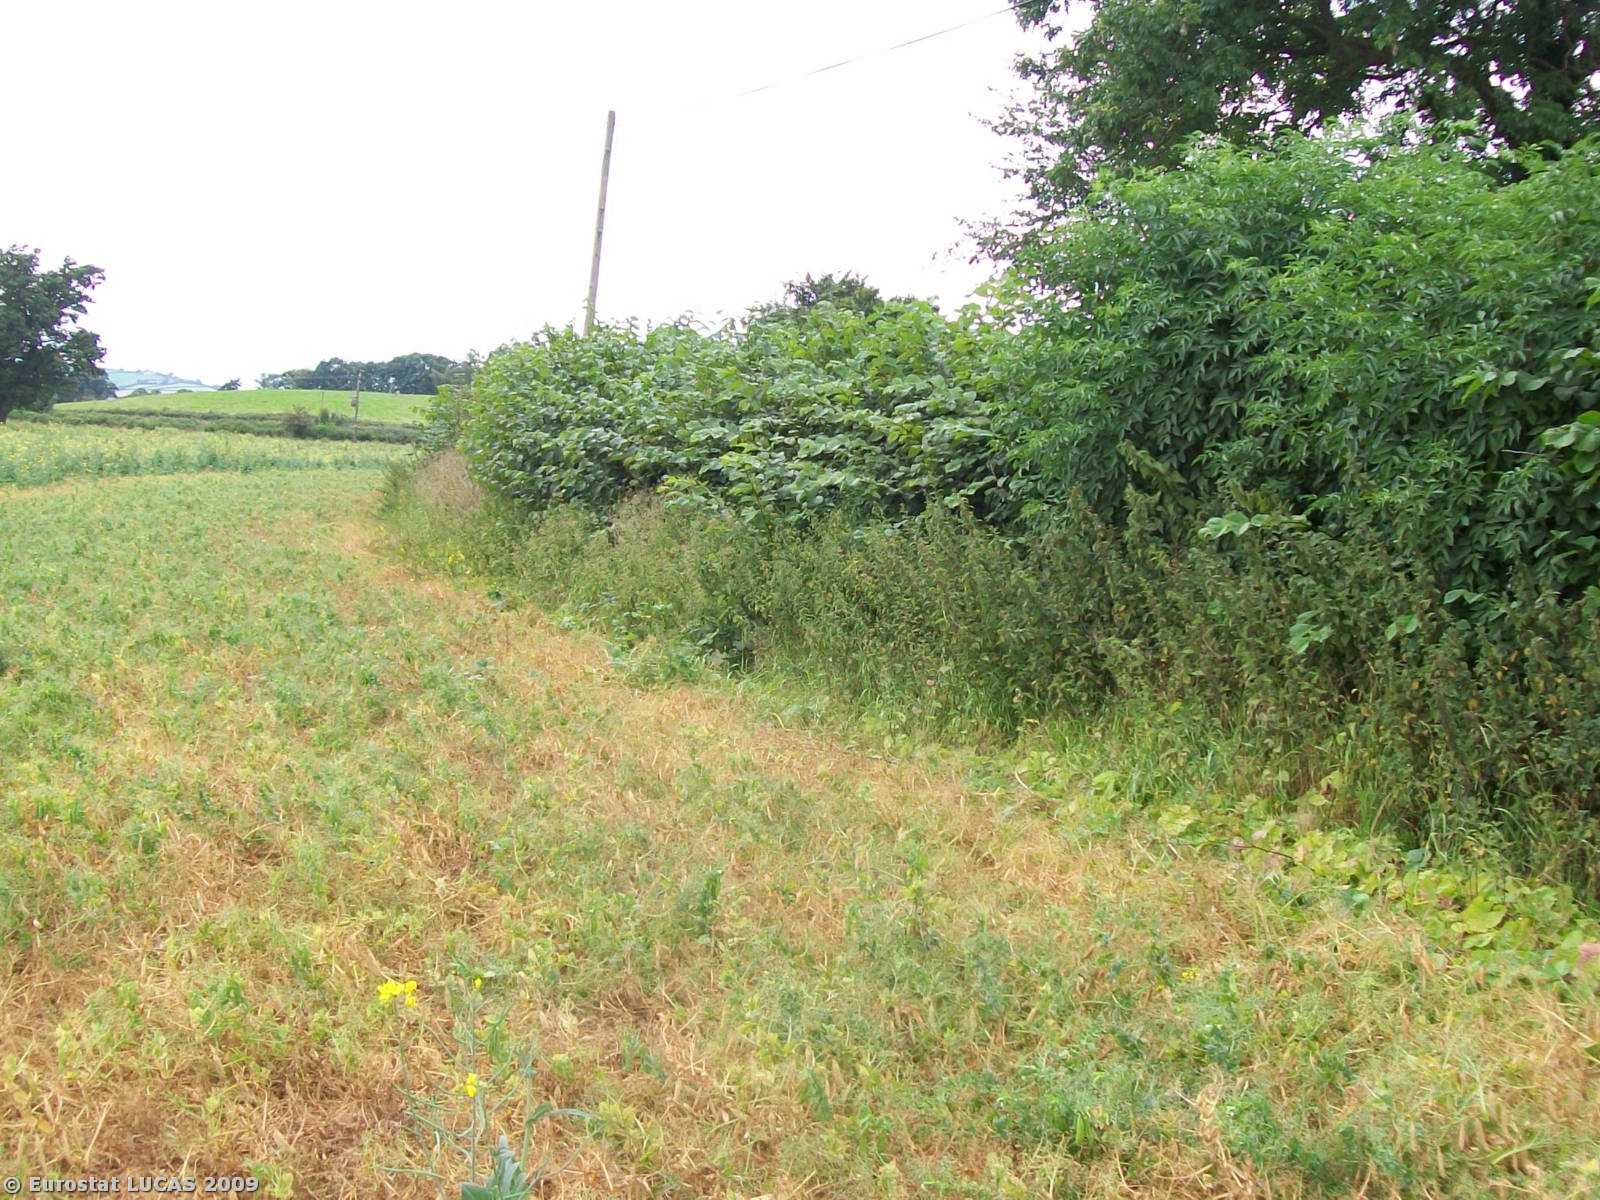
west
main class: Cropland
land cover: Other leguminous and mixtures for fodder
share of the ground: > 75 %
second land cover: Other fresh vegetables
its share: 10 - 25 %
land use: Agriculture (excluding fallow land and kitchen gardens)
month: August
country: GB
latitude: 52.5200
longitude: -3.1198
